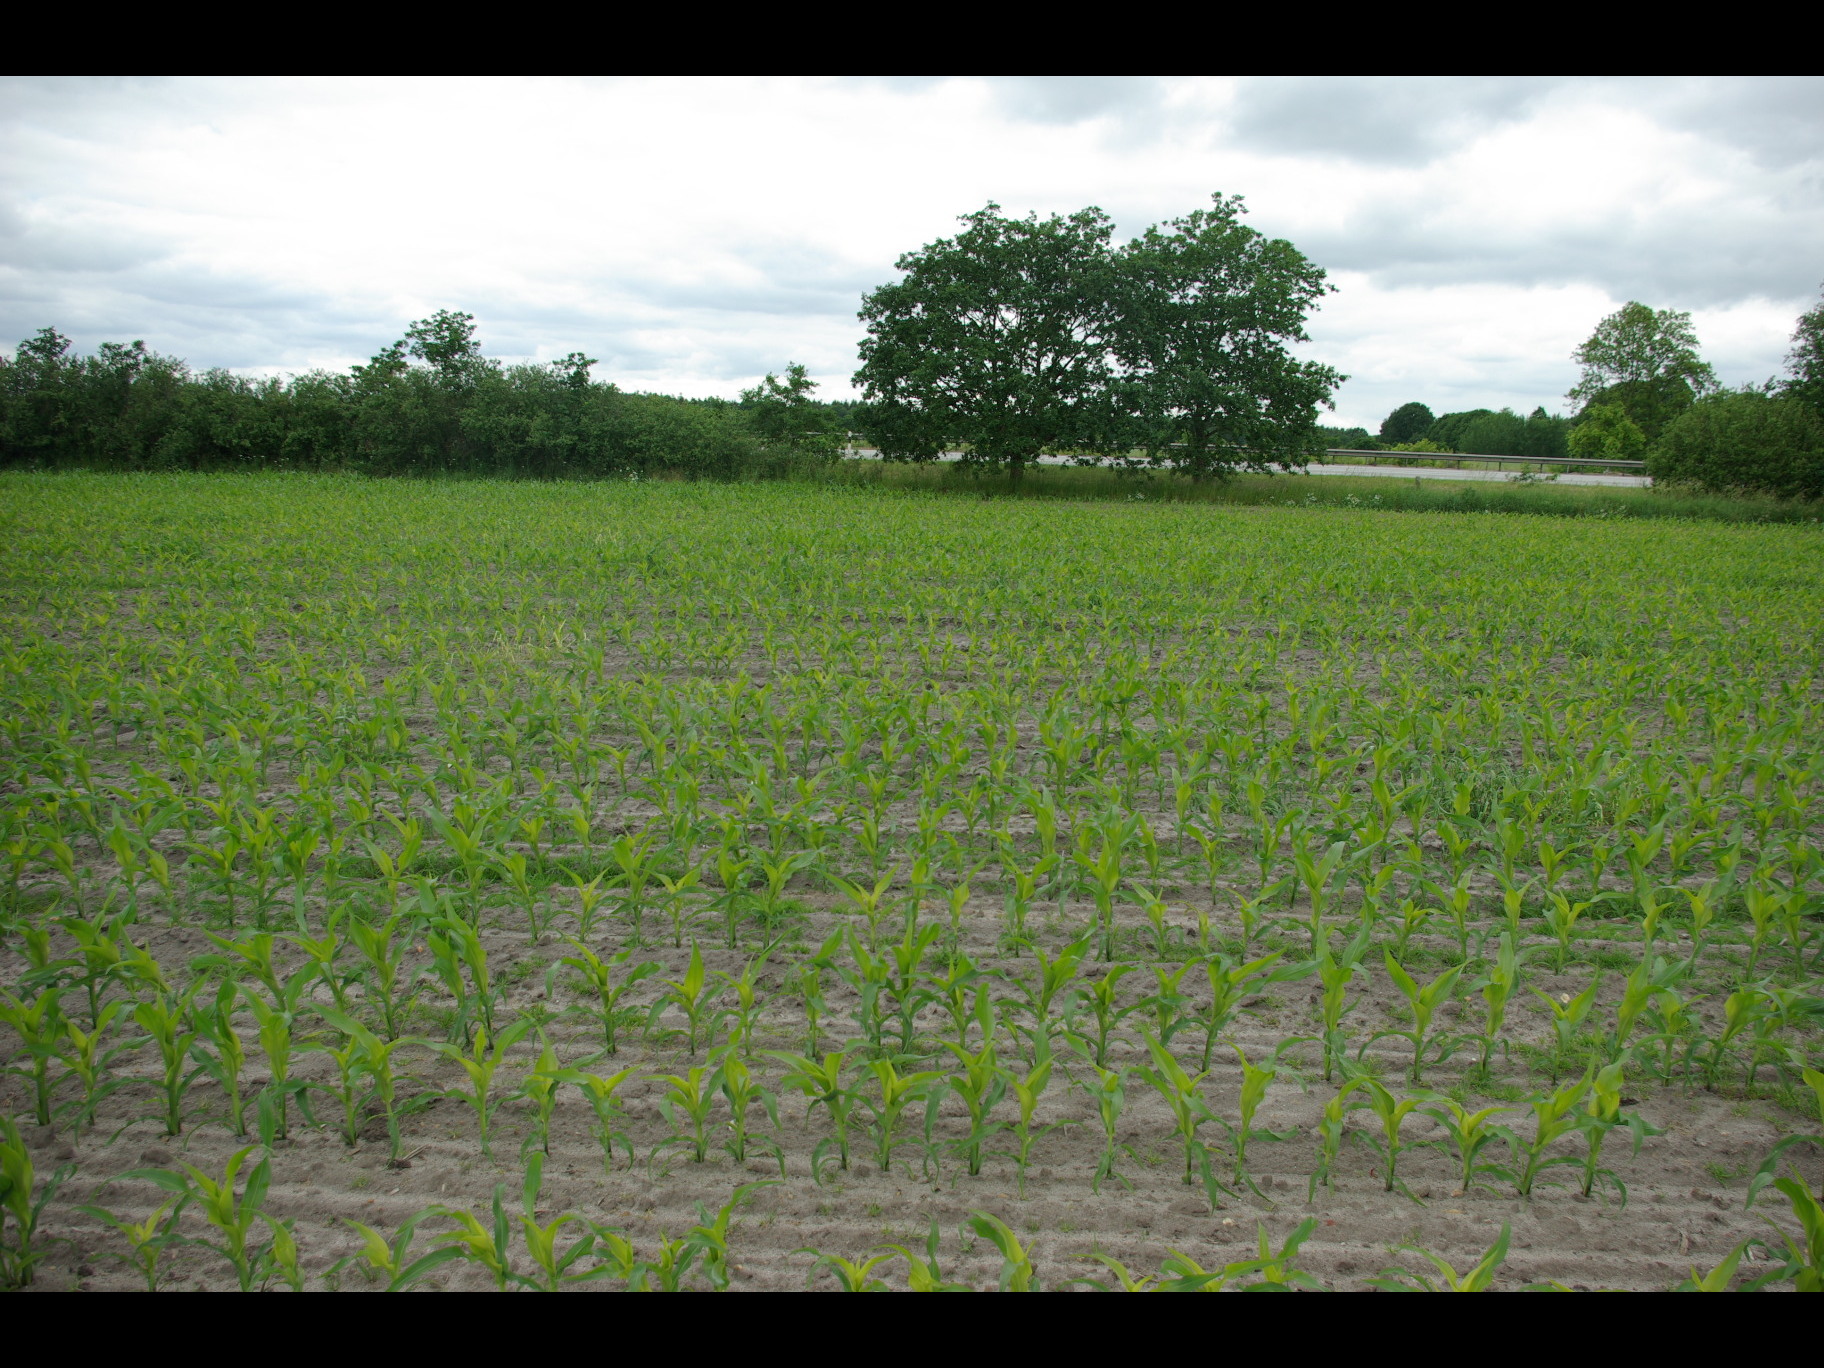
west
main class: Cropland
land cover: Maize
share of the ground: 25 - 50 %
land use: Agriculture (excluding fallow land and kitchen gardens)
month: June
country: DE
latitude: 54.0669
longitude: 9.9236
